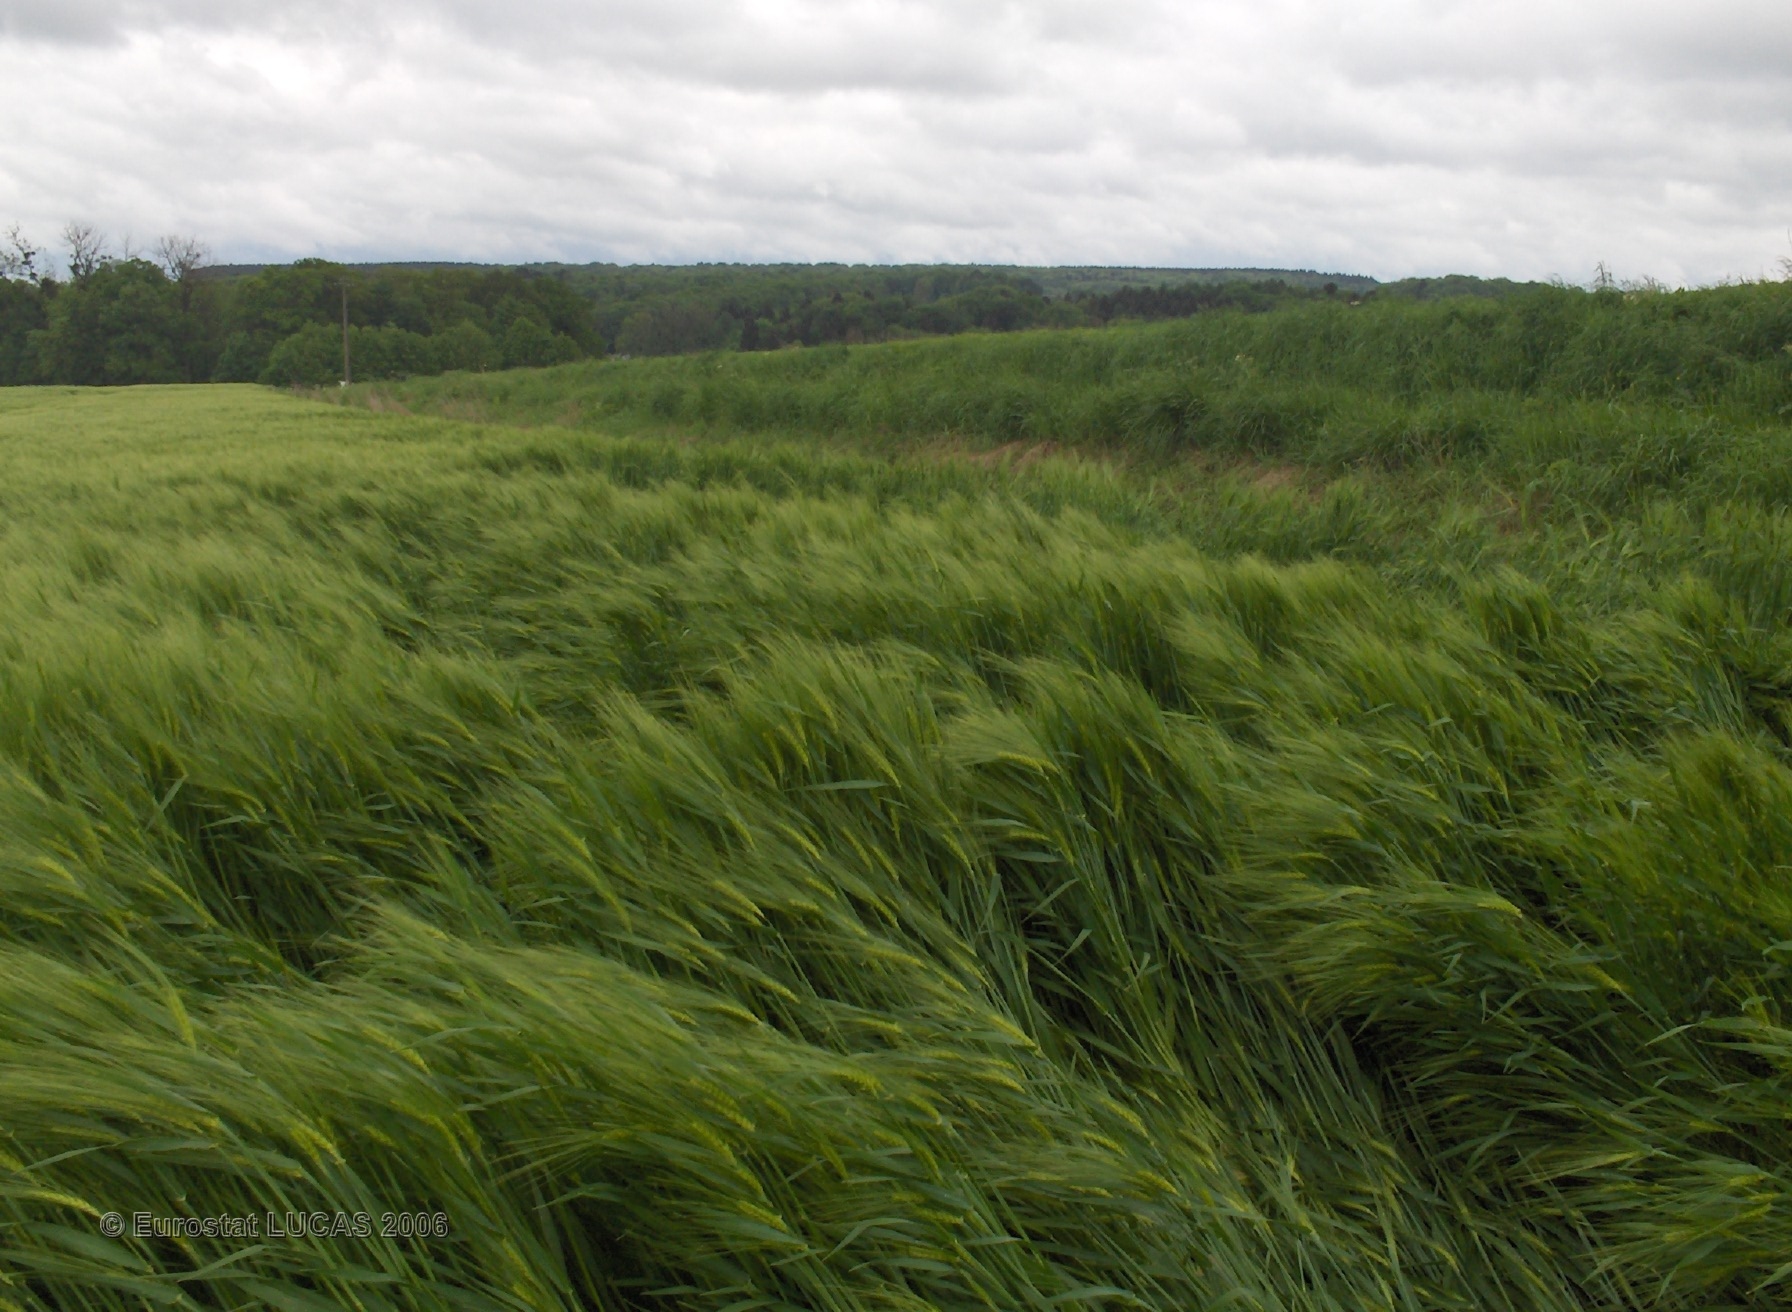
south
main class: Cropland
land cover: Barley
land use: Agriculture (excluding fallow land and kitchen gardens)
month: May
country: BE
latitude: 50.4277
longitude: 5.2539
